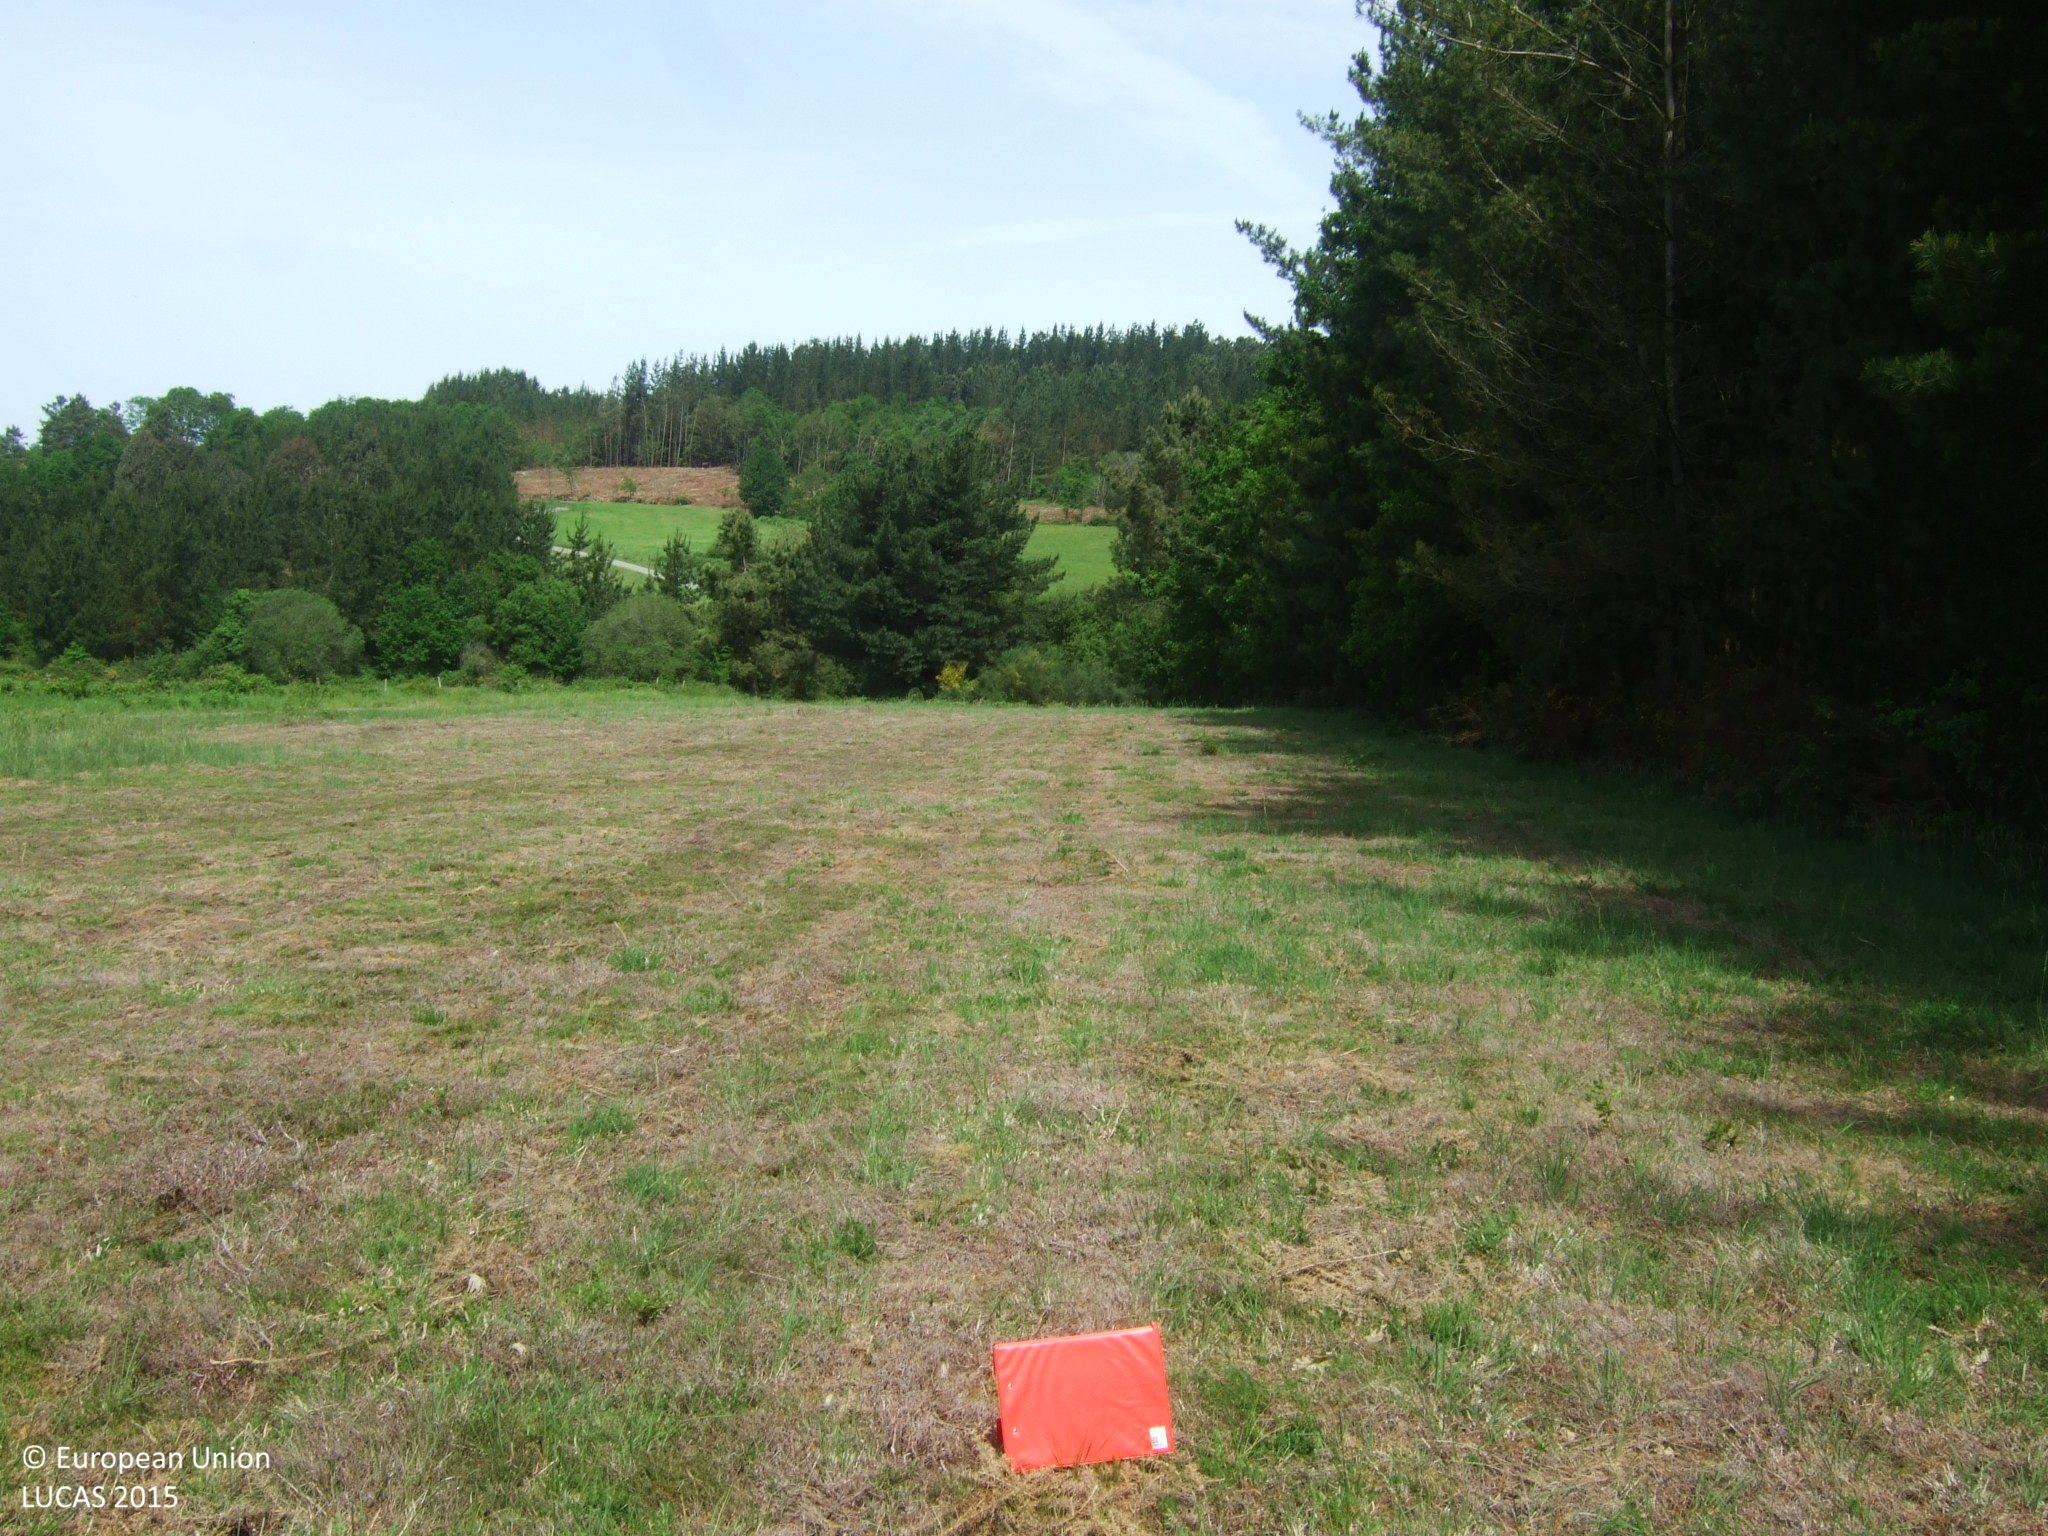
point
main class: Grassland
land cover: Grassland without tree/shrub cover
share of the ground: > 75 %
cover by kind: herbaceous plants 100 %
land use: Agriculture (excluding fallow land and kitchen gardens)
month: May
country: ES
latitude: 42.8856
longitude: -7.3966
